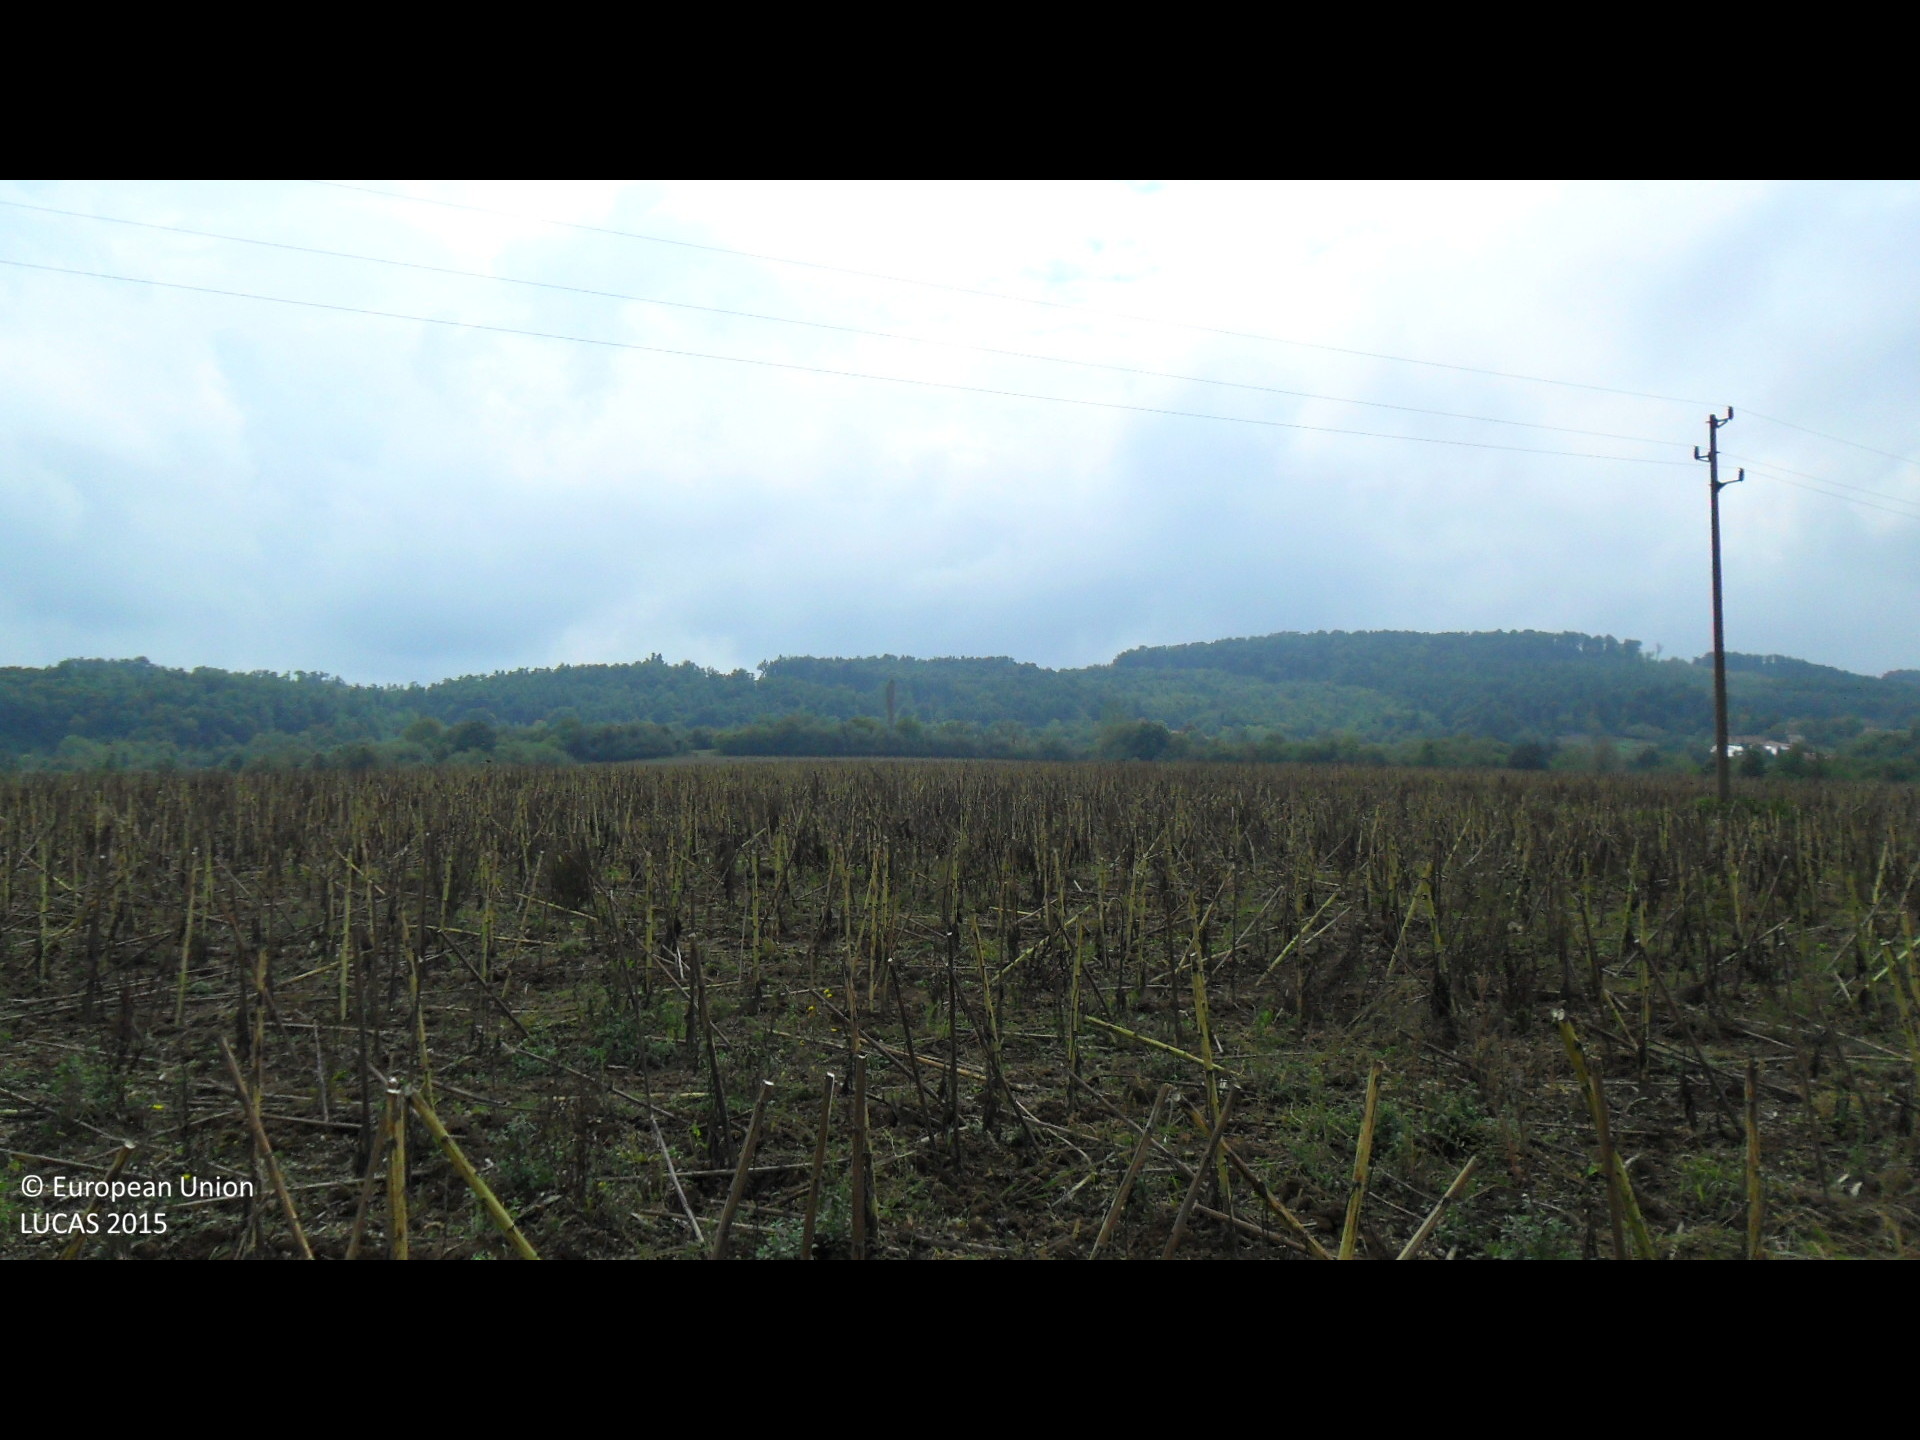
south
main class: Cropland
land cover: Sunflower
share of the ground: 50 - 75 %
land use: Agriculture (excluding fallow land and kitchen gardens)
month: September
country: BG
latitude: 43.0668
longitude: 26.3170
